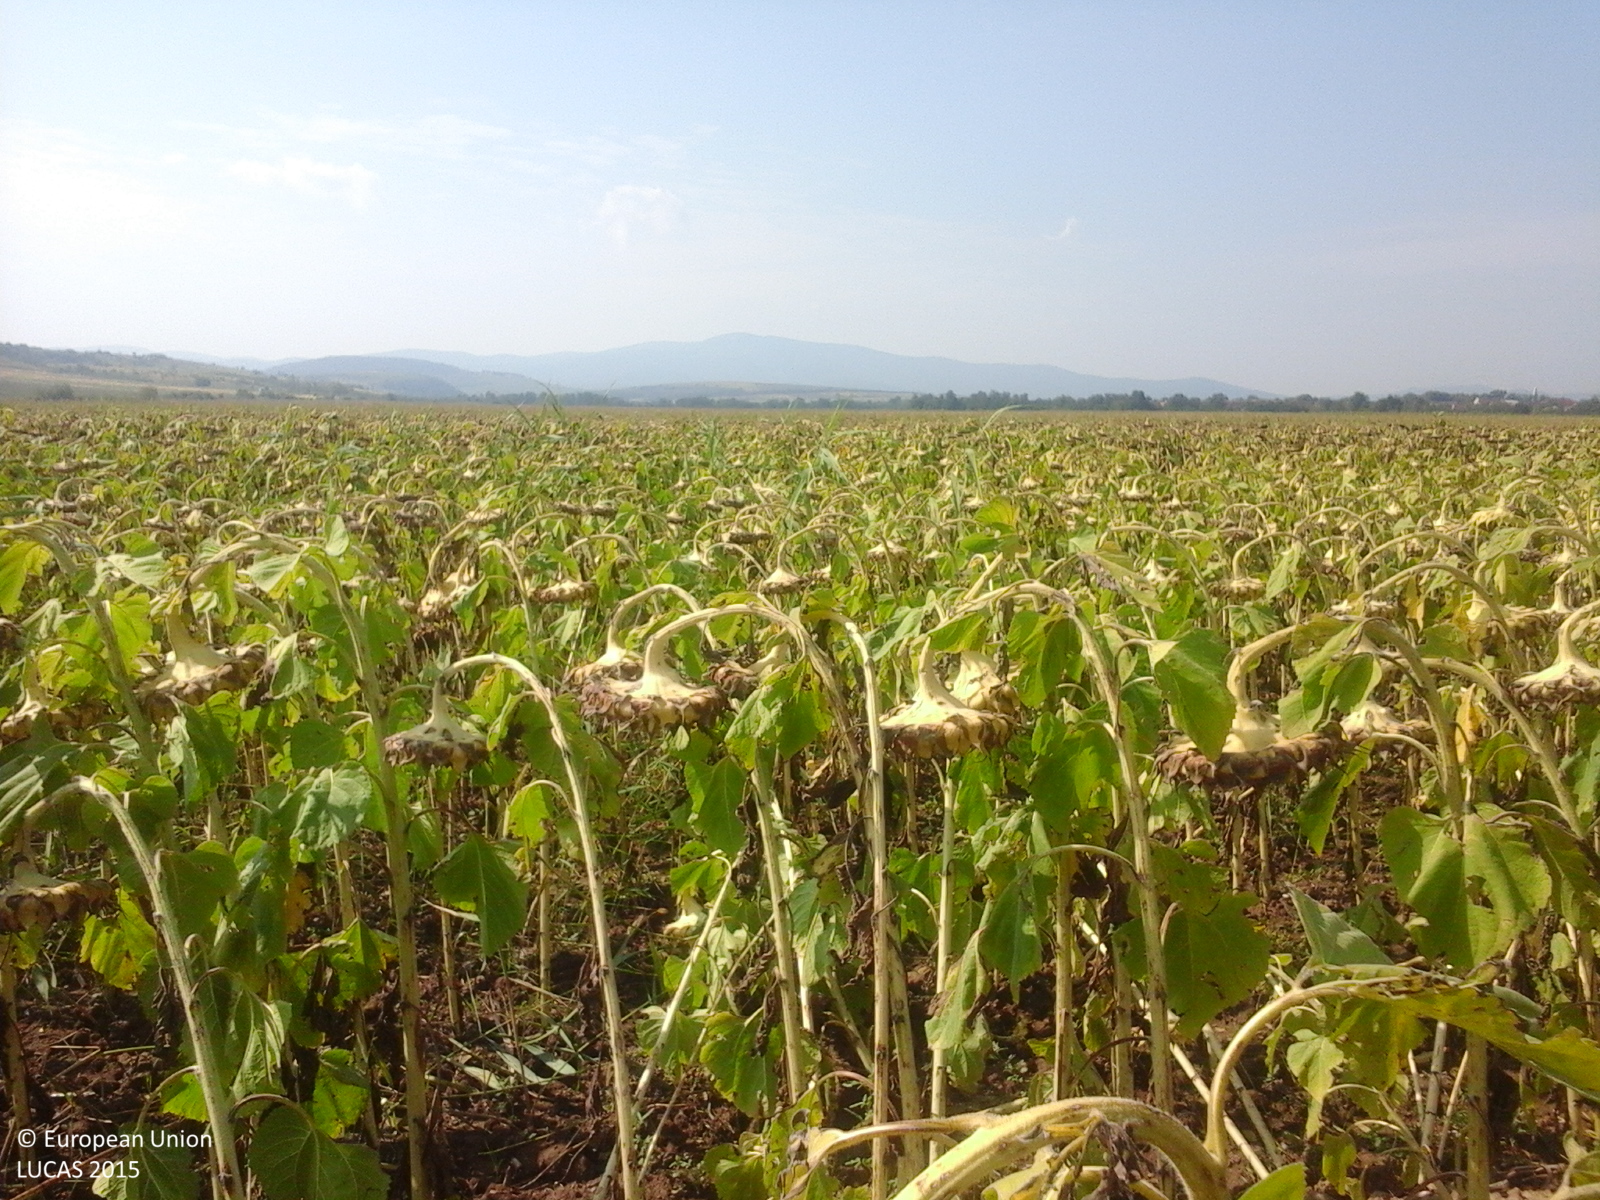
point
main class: Cropland
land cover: Sunflower
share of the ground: > 75 %
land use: Agriculture (excluding fallow land and kitchen gardens)
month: August
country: RO
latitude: 46.3063
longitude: 21.8702
